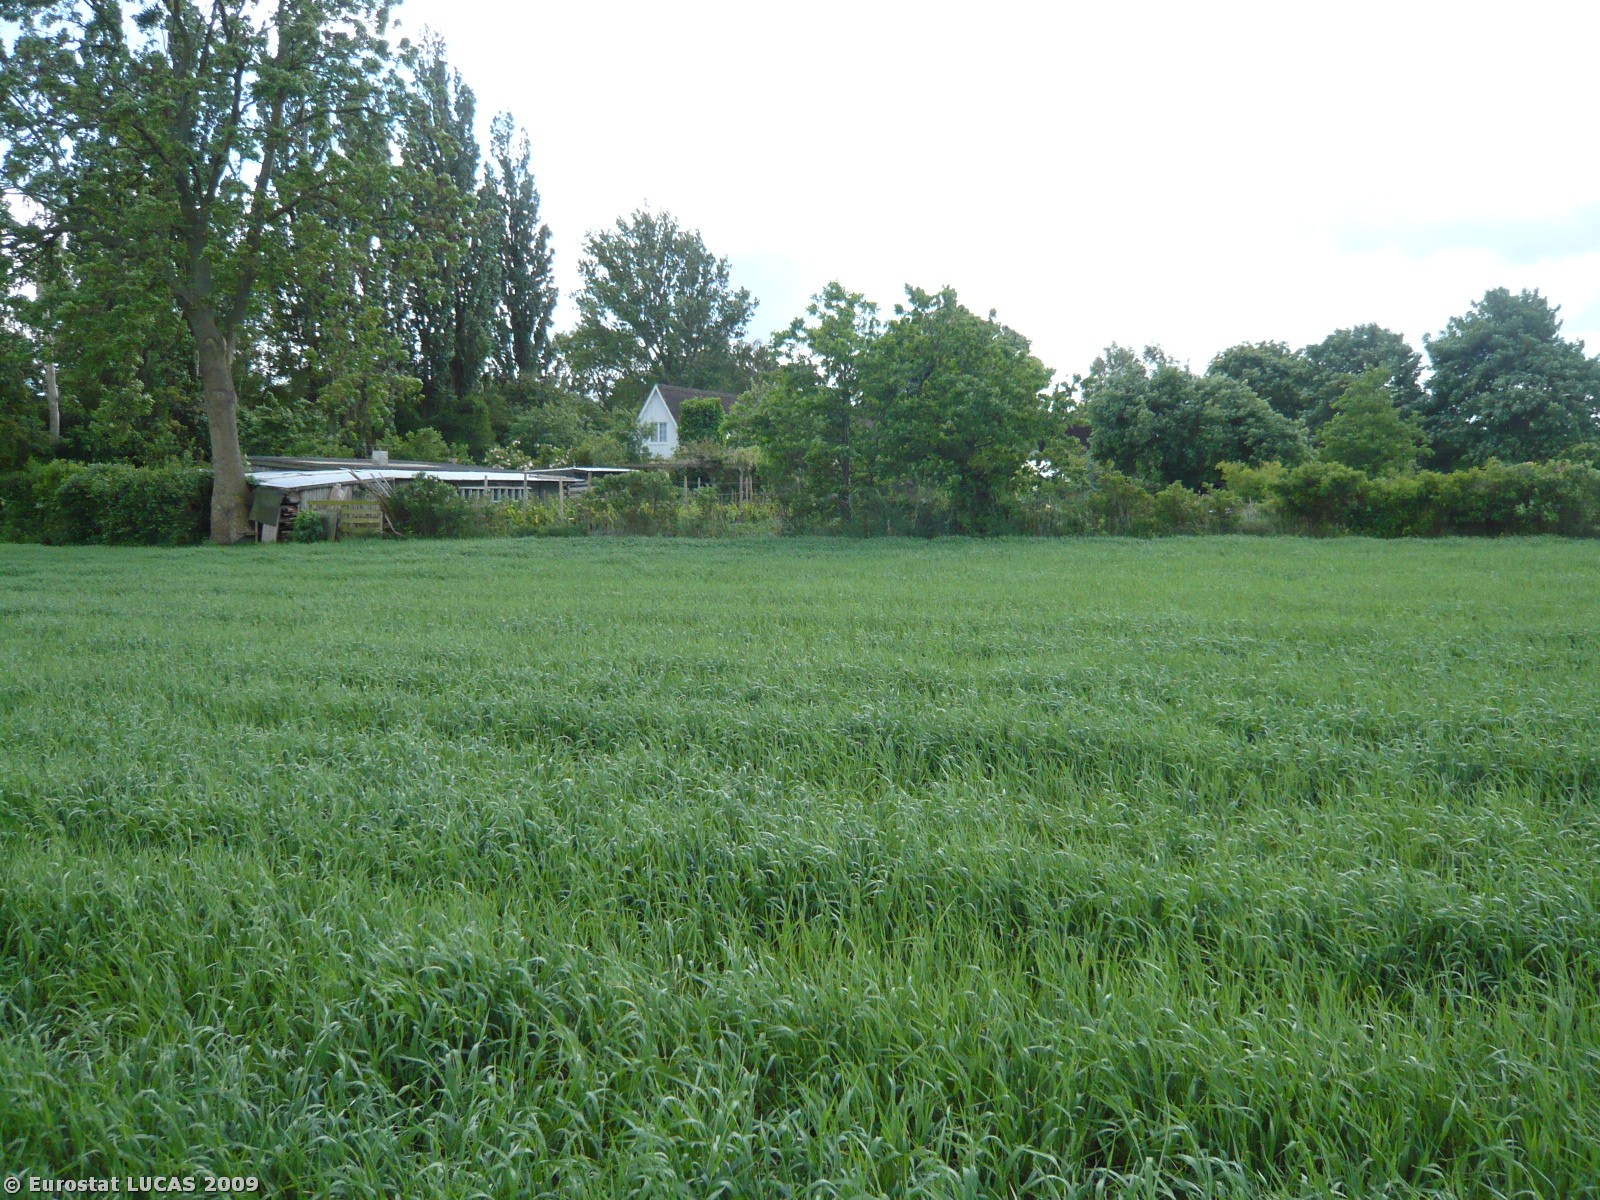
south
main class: Cropland
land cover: Barley
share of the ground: > 75 %
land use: Agriculture (excluding fallow land and kitchen gardens)
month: June
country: DK
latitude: 55.2255
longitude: 11.5552
